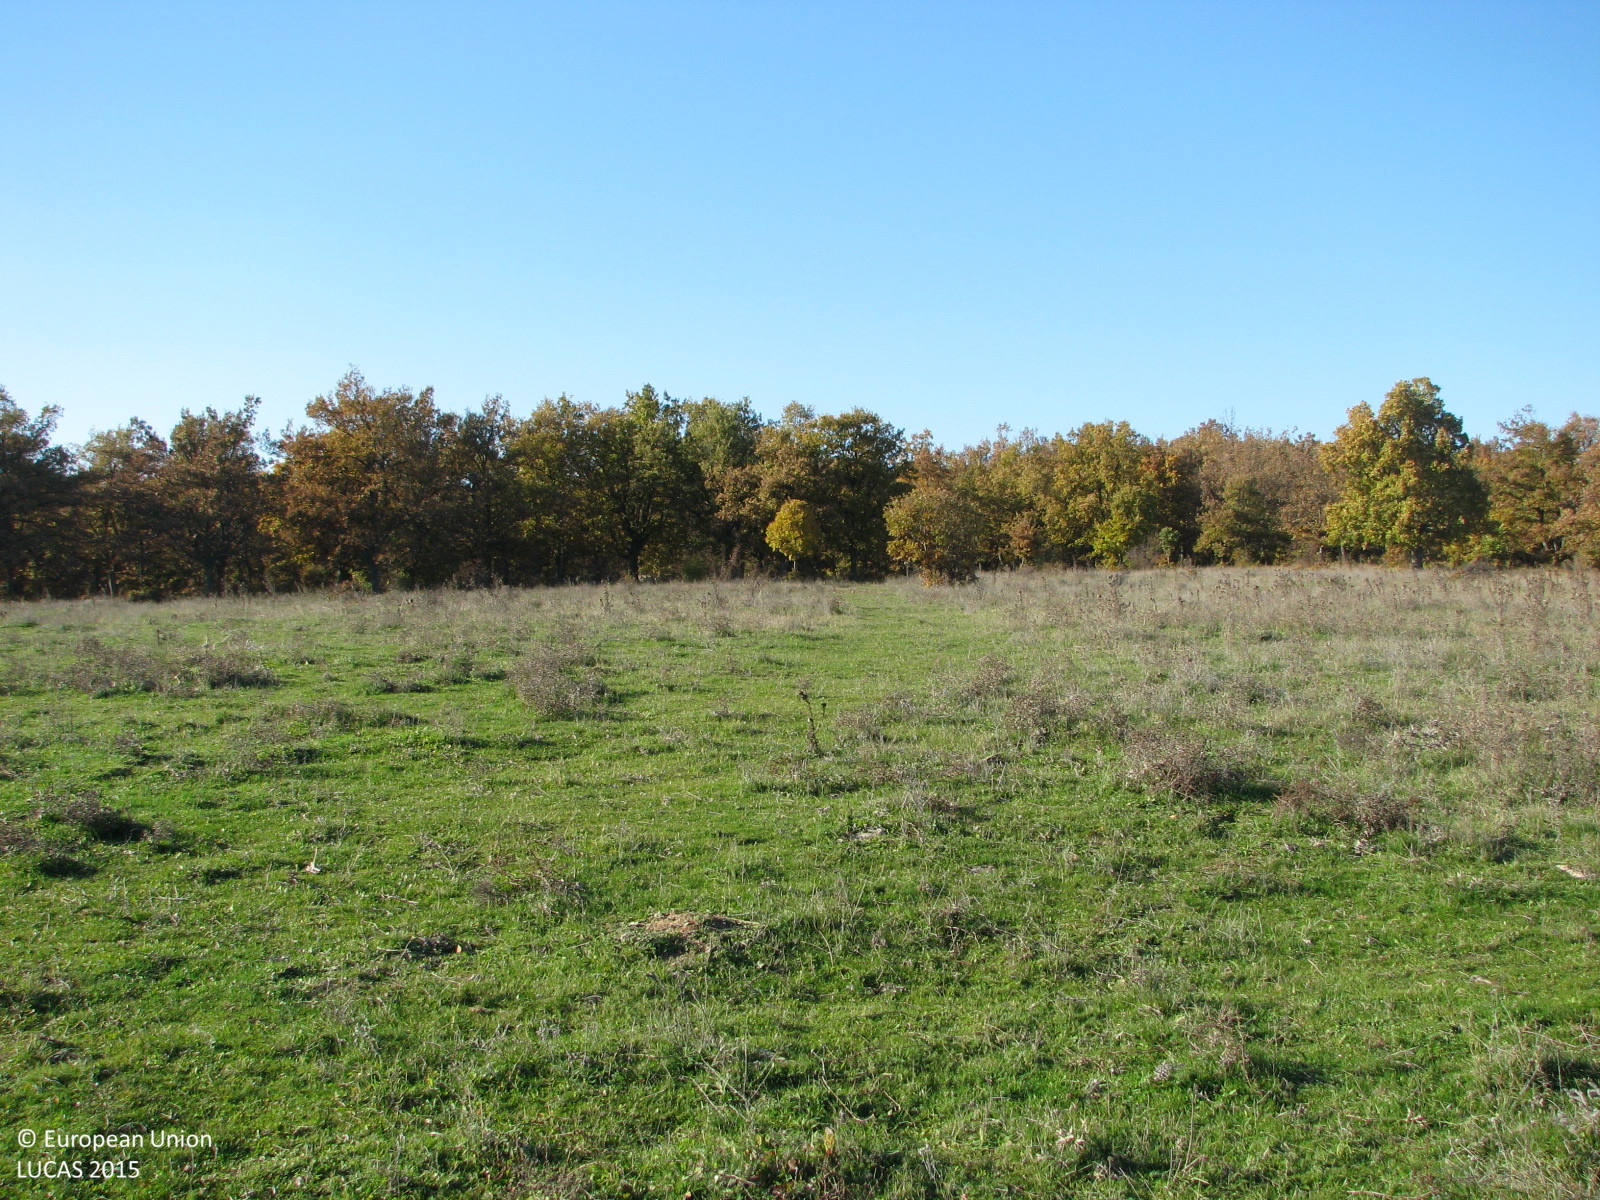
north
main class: Grassland
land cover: Grassland without tree/shrub cover
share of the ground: > 75 %
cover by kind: herbaceous plants 100 %
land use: Agriculture (excluding fallow land and kitchen gardens)
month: November
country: BG
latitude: 42.0659
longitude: 26.8079
